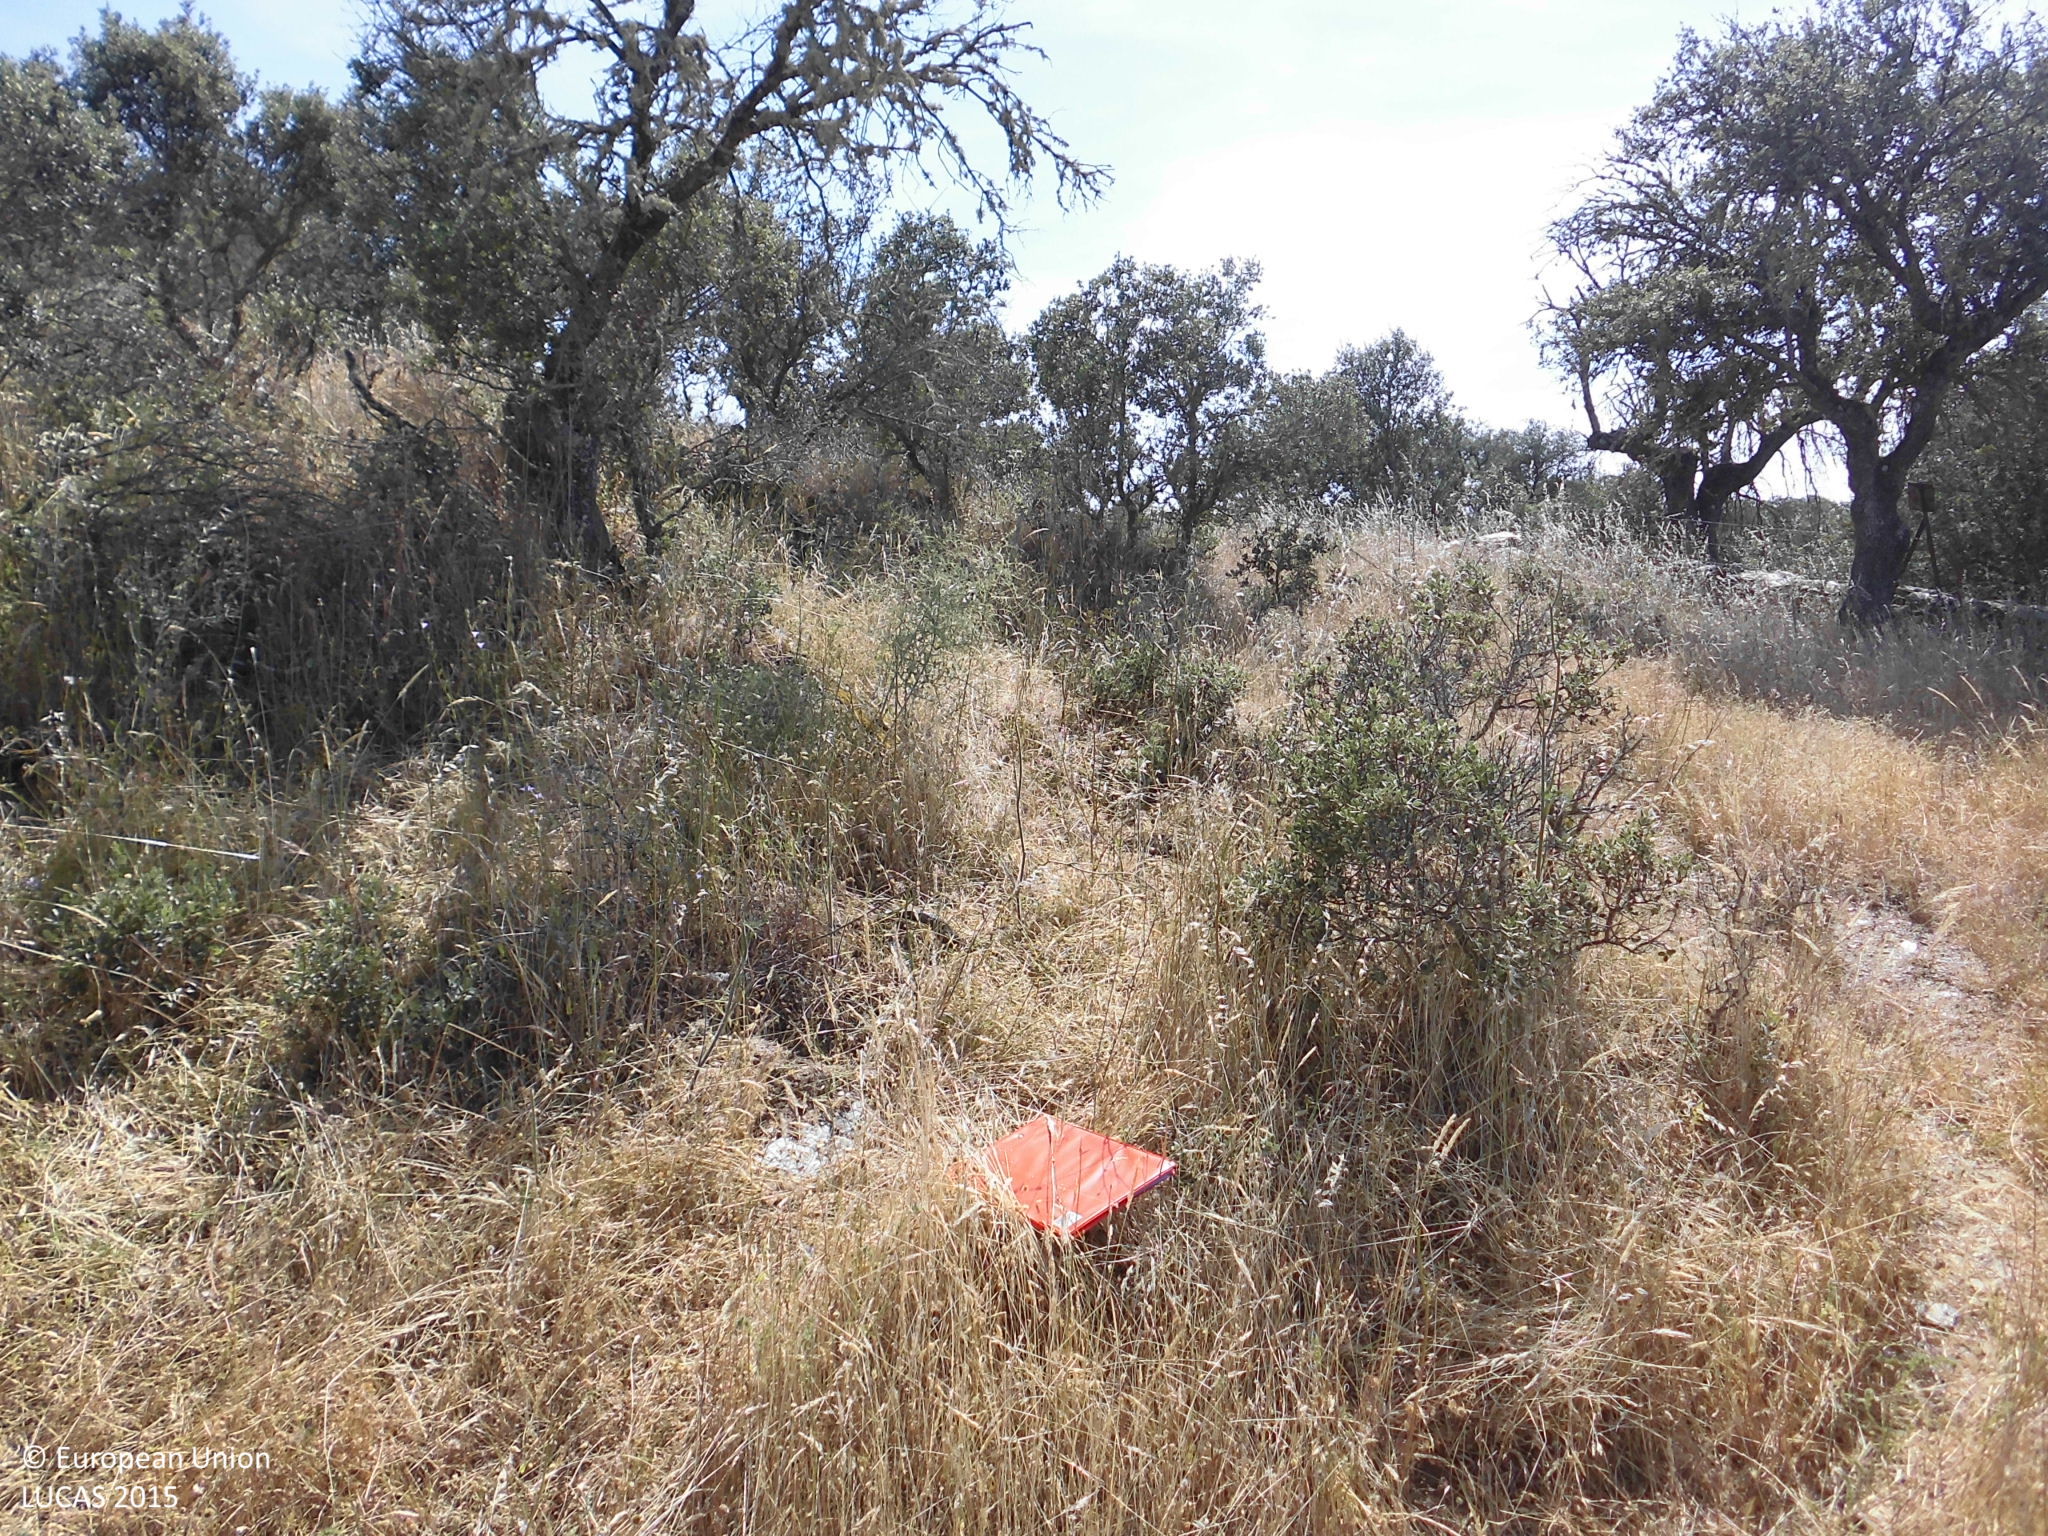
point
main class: Shrubland
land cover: Shrubland with sparse tree cover
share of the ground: 25 - 50 %
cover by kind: shrubs 40 %, herbaceous plants 30 %, unconsolidated bare surface 25 %, broadleaved forest trees 5 %
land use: Forestry
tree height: < 5 m
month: May
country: ES
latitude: 39.4532
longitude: -6.0402
